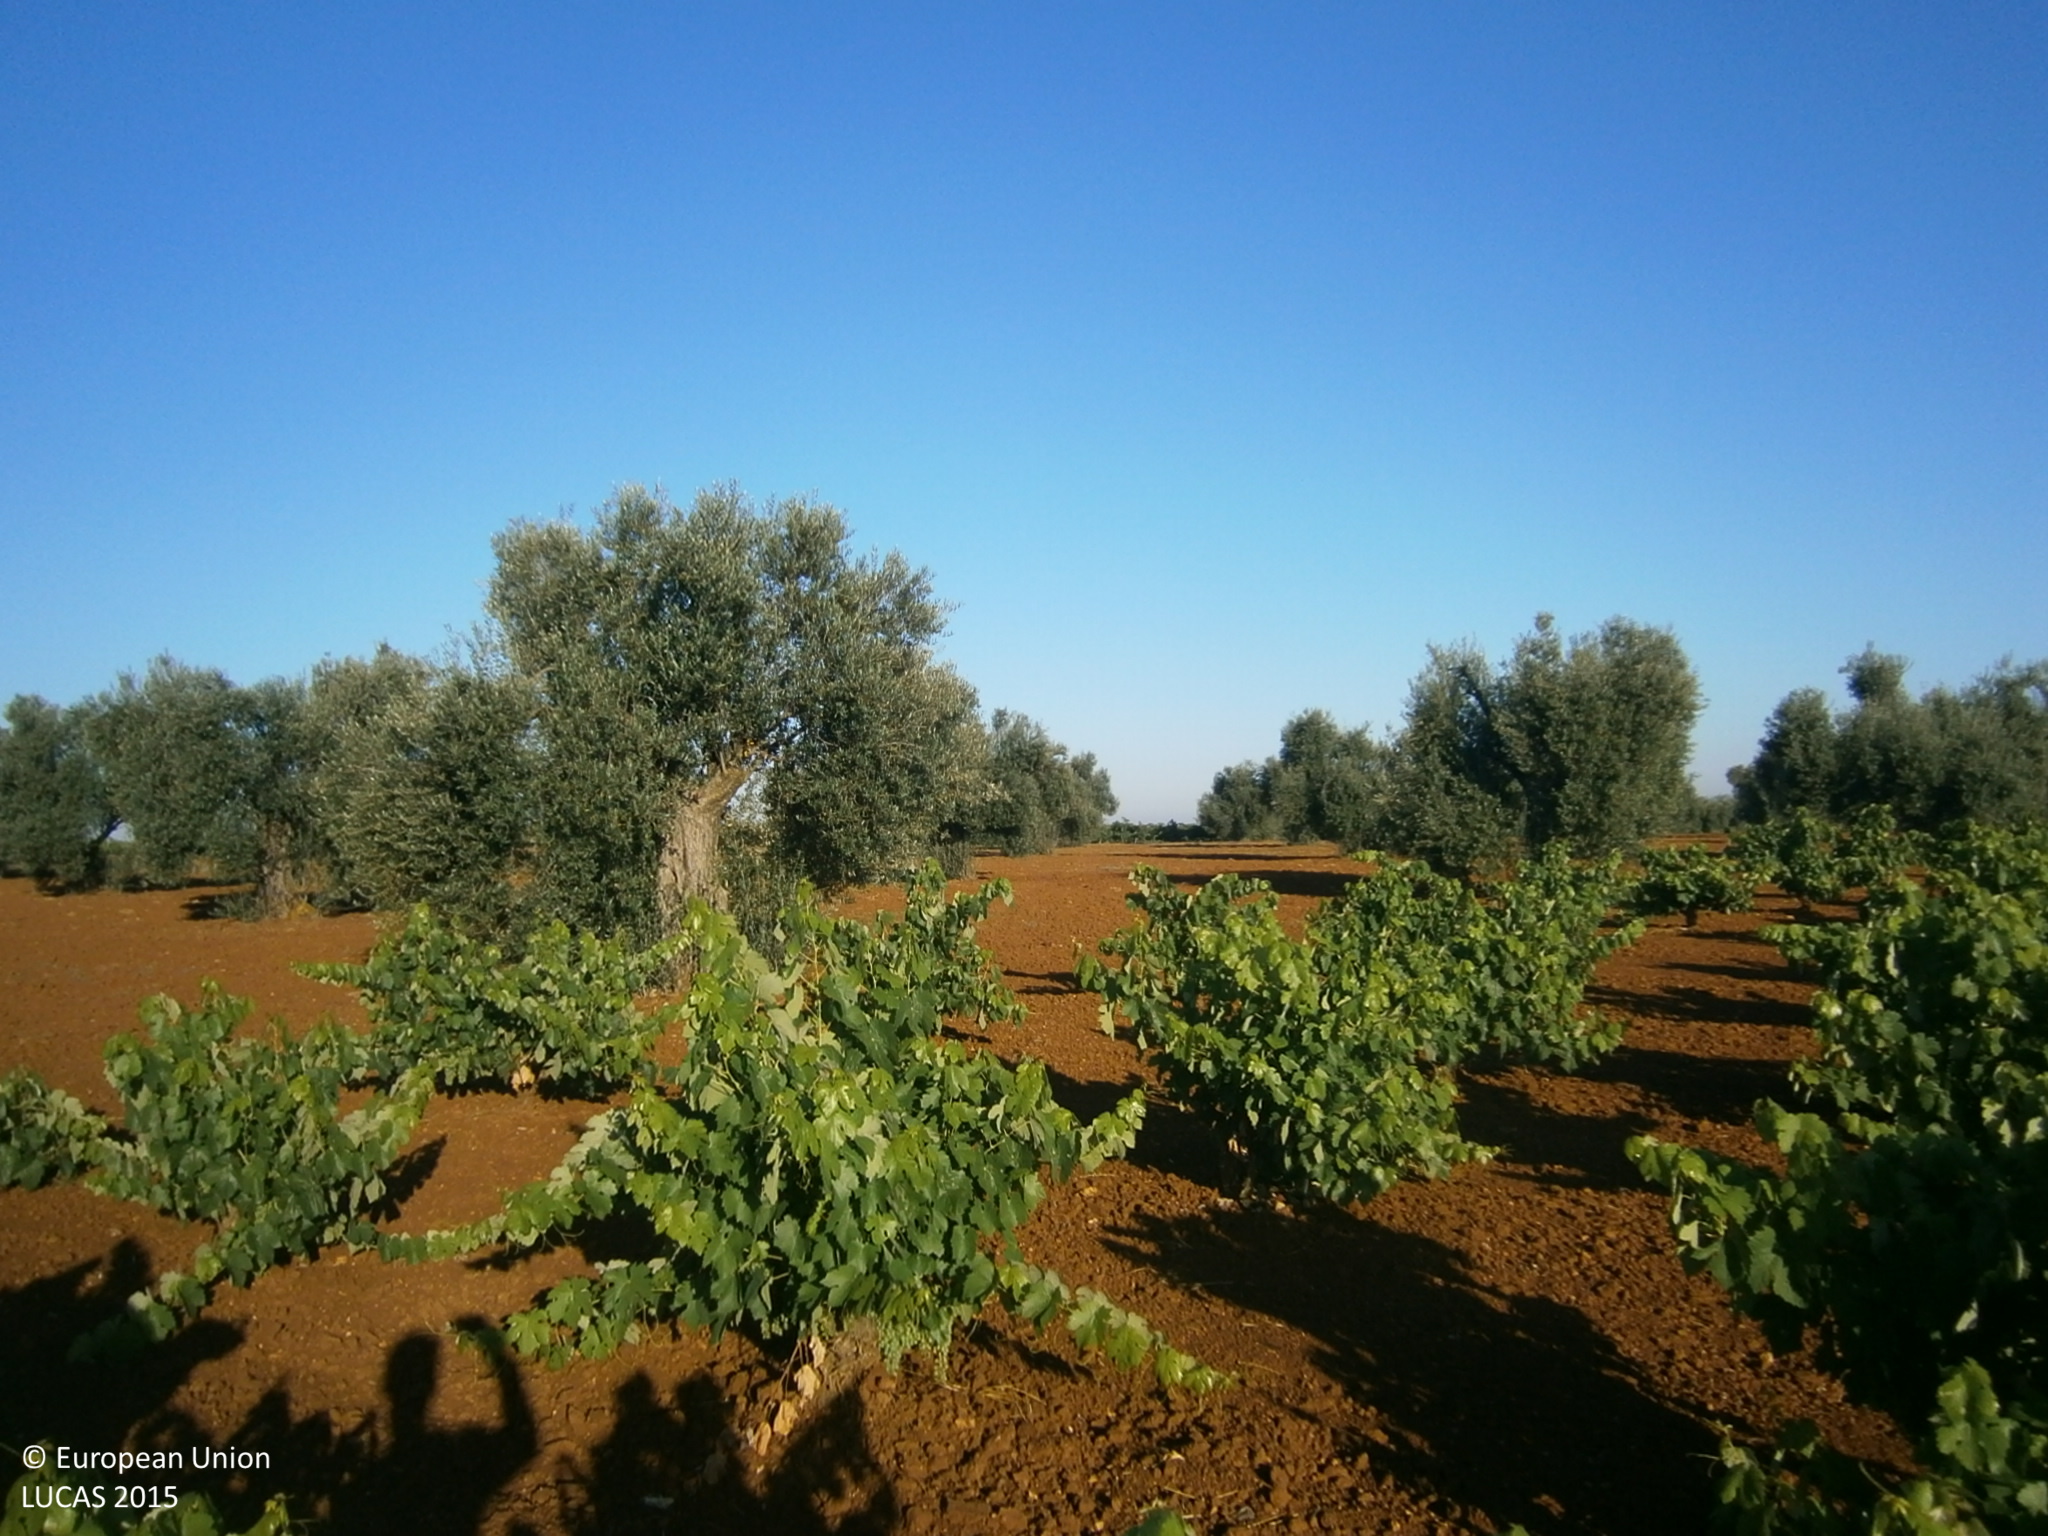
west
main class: Cropland
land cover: Vineyards
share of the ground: 25 - 50 %
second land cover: Other bare soil
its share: > 75 %
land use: Agriculture (excluding fallow land and kitchen gardens)
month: June
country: ES
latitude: 38.7566
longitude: -6.4550
